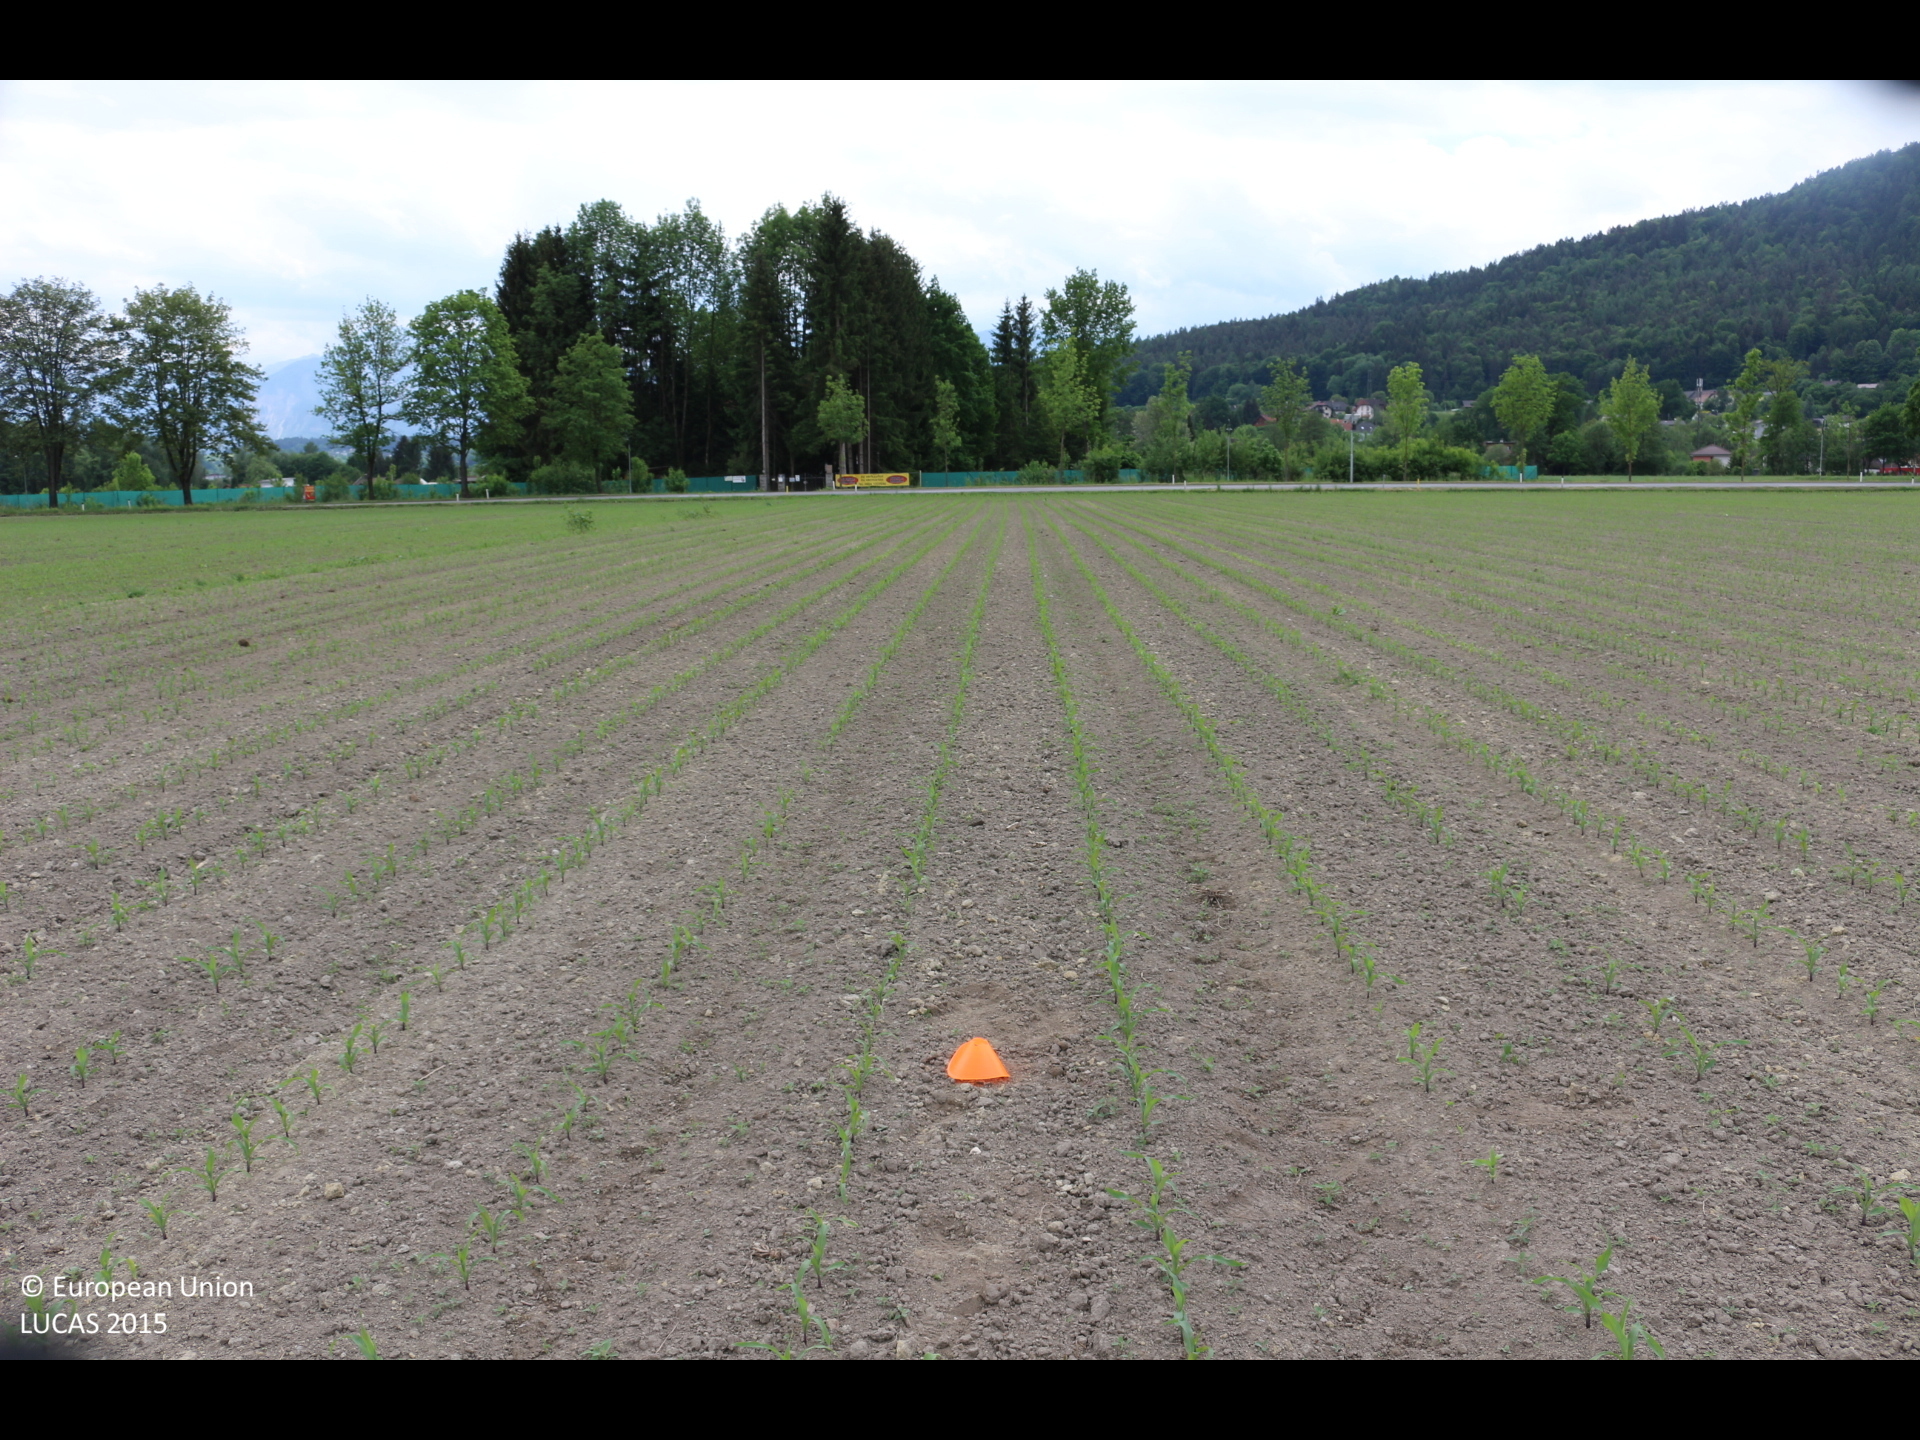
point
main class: Cropland
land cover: Maize
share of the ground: 10 - 25 %
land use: Agriculture (excluding fallow land and kitchen gardens)
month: May
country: AT
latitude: 46.6088
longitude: 14.2668
